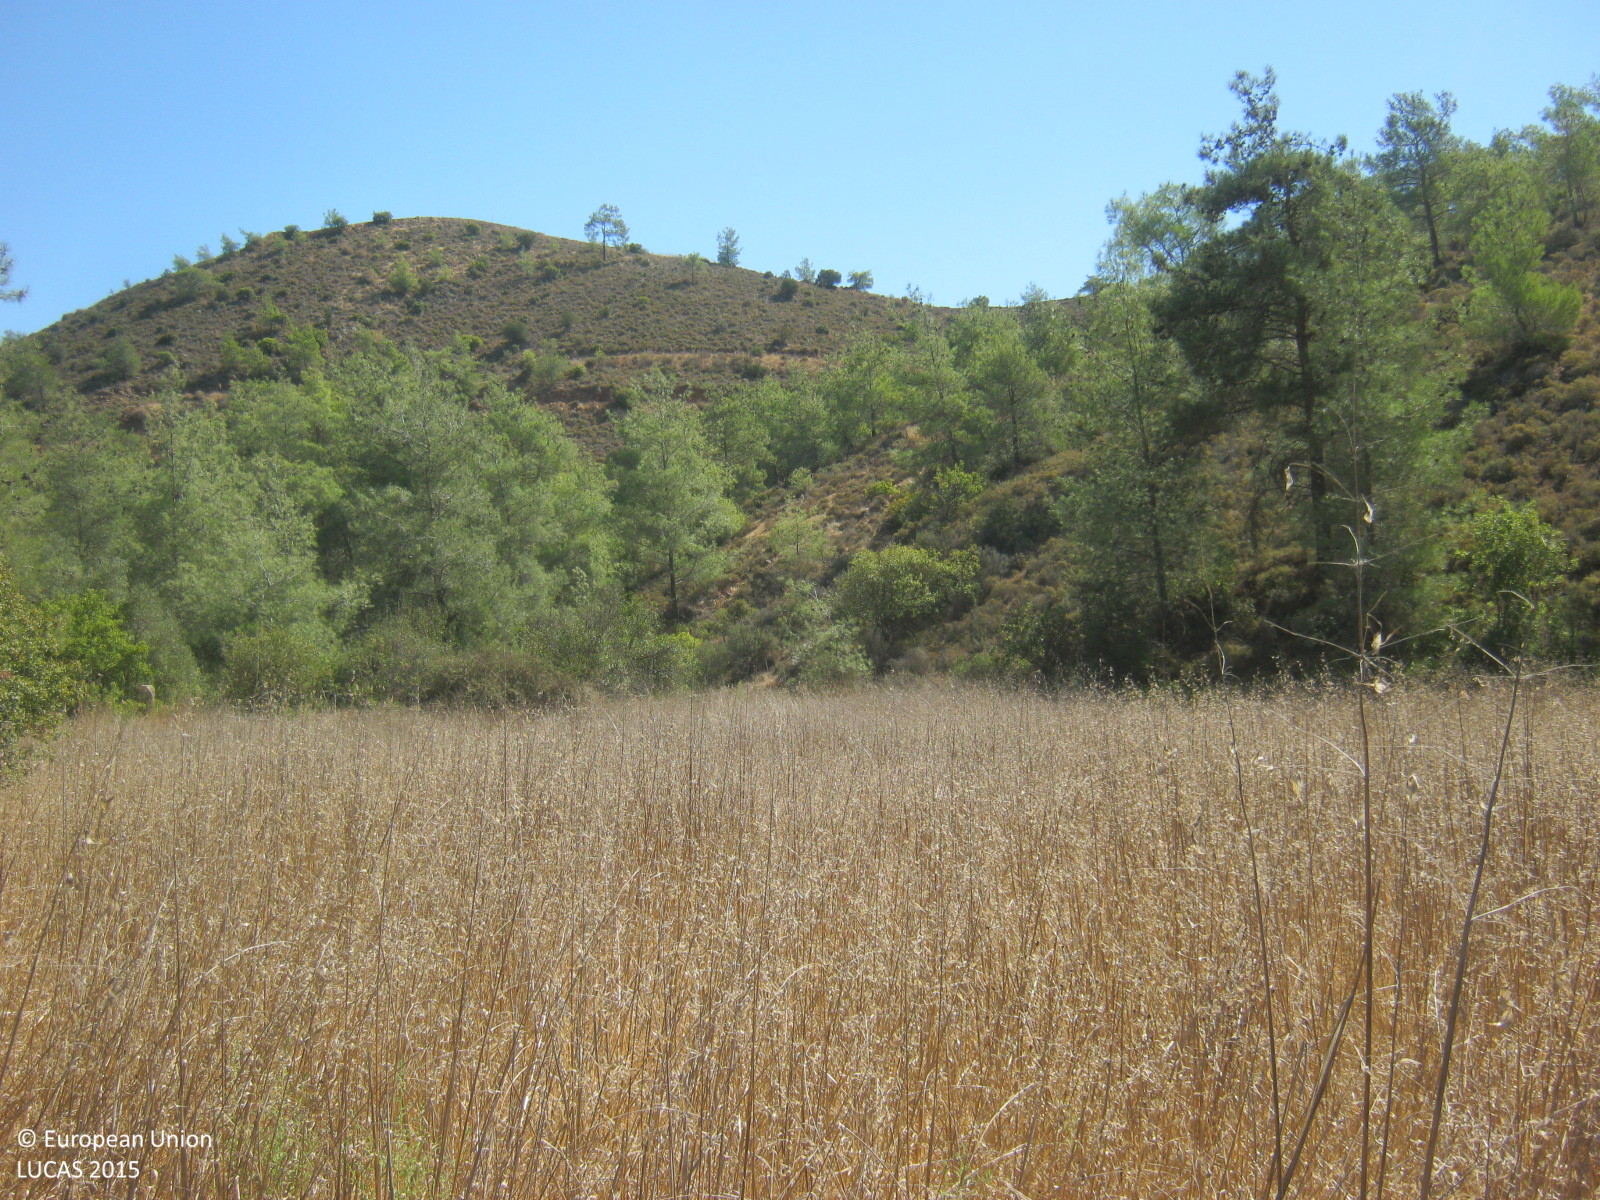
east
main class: Shrubland
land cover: Shrubland without tree cover
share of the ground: 50 - 75 %
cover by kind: shrubs 50 %, unconsolidated bare surface 30 %, herbaceous plants 20 %
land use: Semi-natural and natural areas not in use
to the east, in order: Spontaneously vegetated surfaces; Pine dominated coniferous woodland; Rivers and streams; Pine dominated coniferous woodland; Shrubland without tree cover; Shrubland with sparse tree cover; Rivers and streams; Shrubland without tree cover; Tracks; Shrubland without tree cover
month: April
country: CY
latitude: 34.9435
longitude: 33.3661
